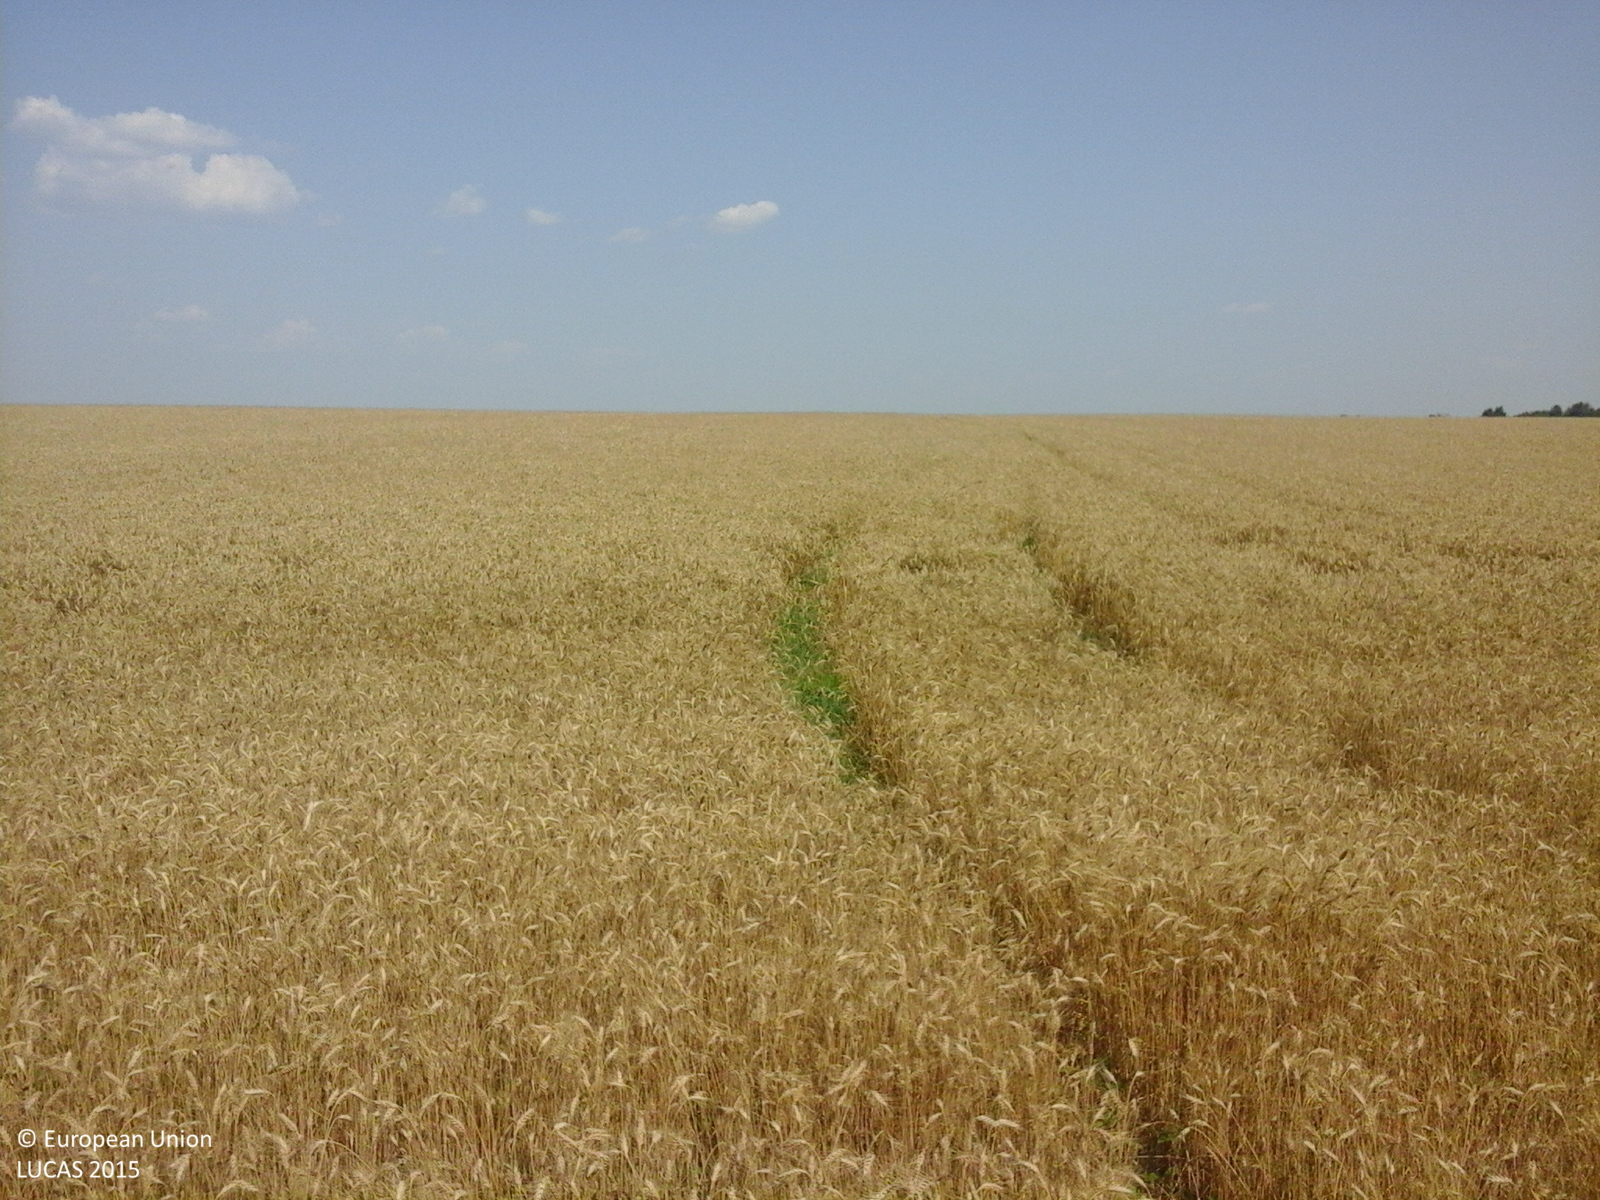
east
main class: Cropland
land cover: Common wheat
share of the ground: > 75 %
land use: Agriculture (excluding fallow land and kitchen gardens)
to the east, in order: Common wheat
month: July
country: RO
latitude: 44.6809
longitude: 24.4927
